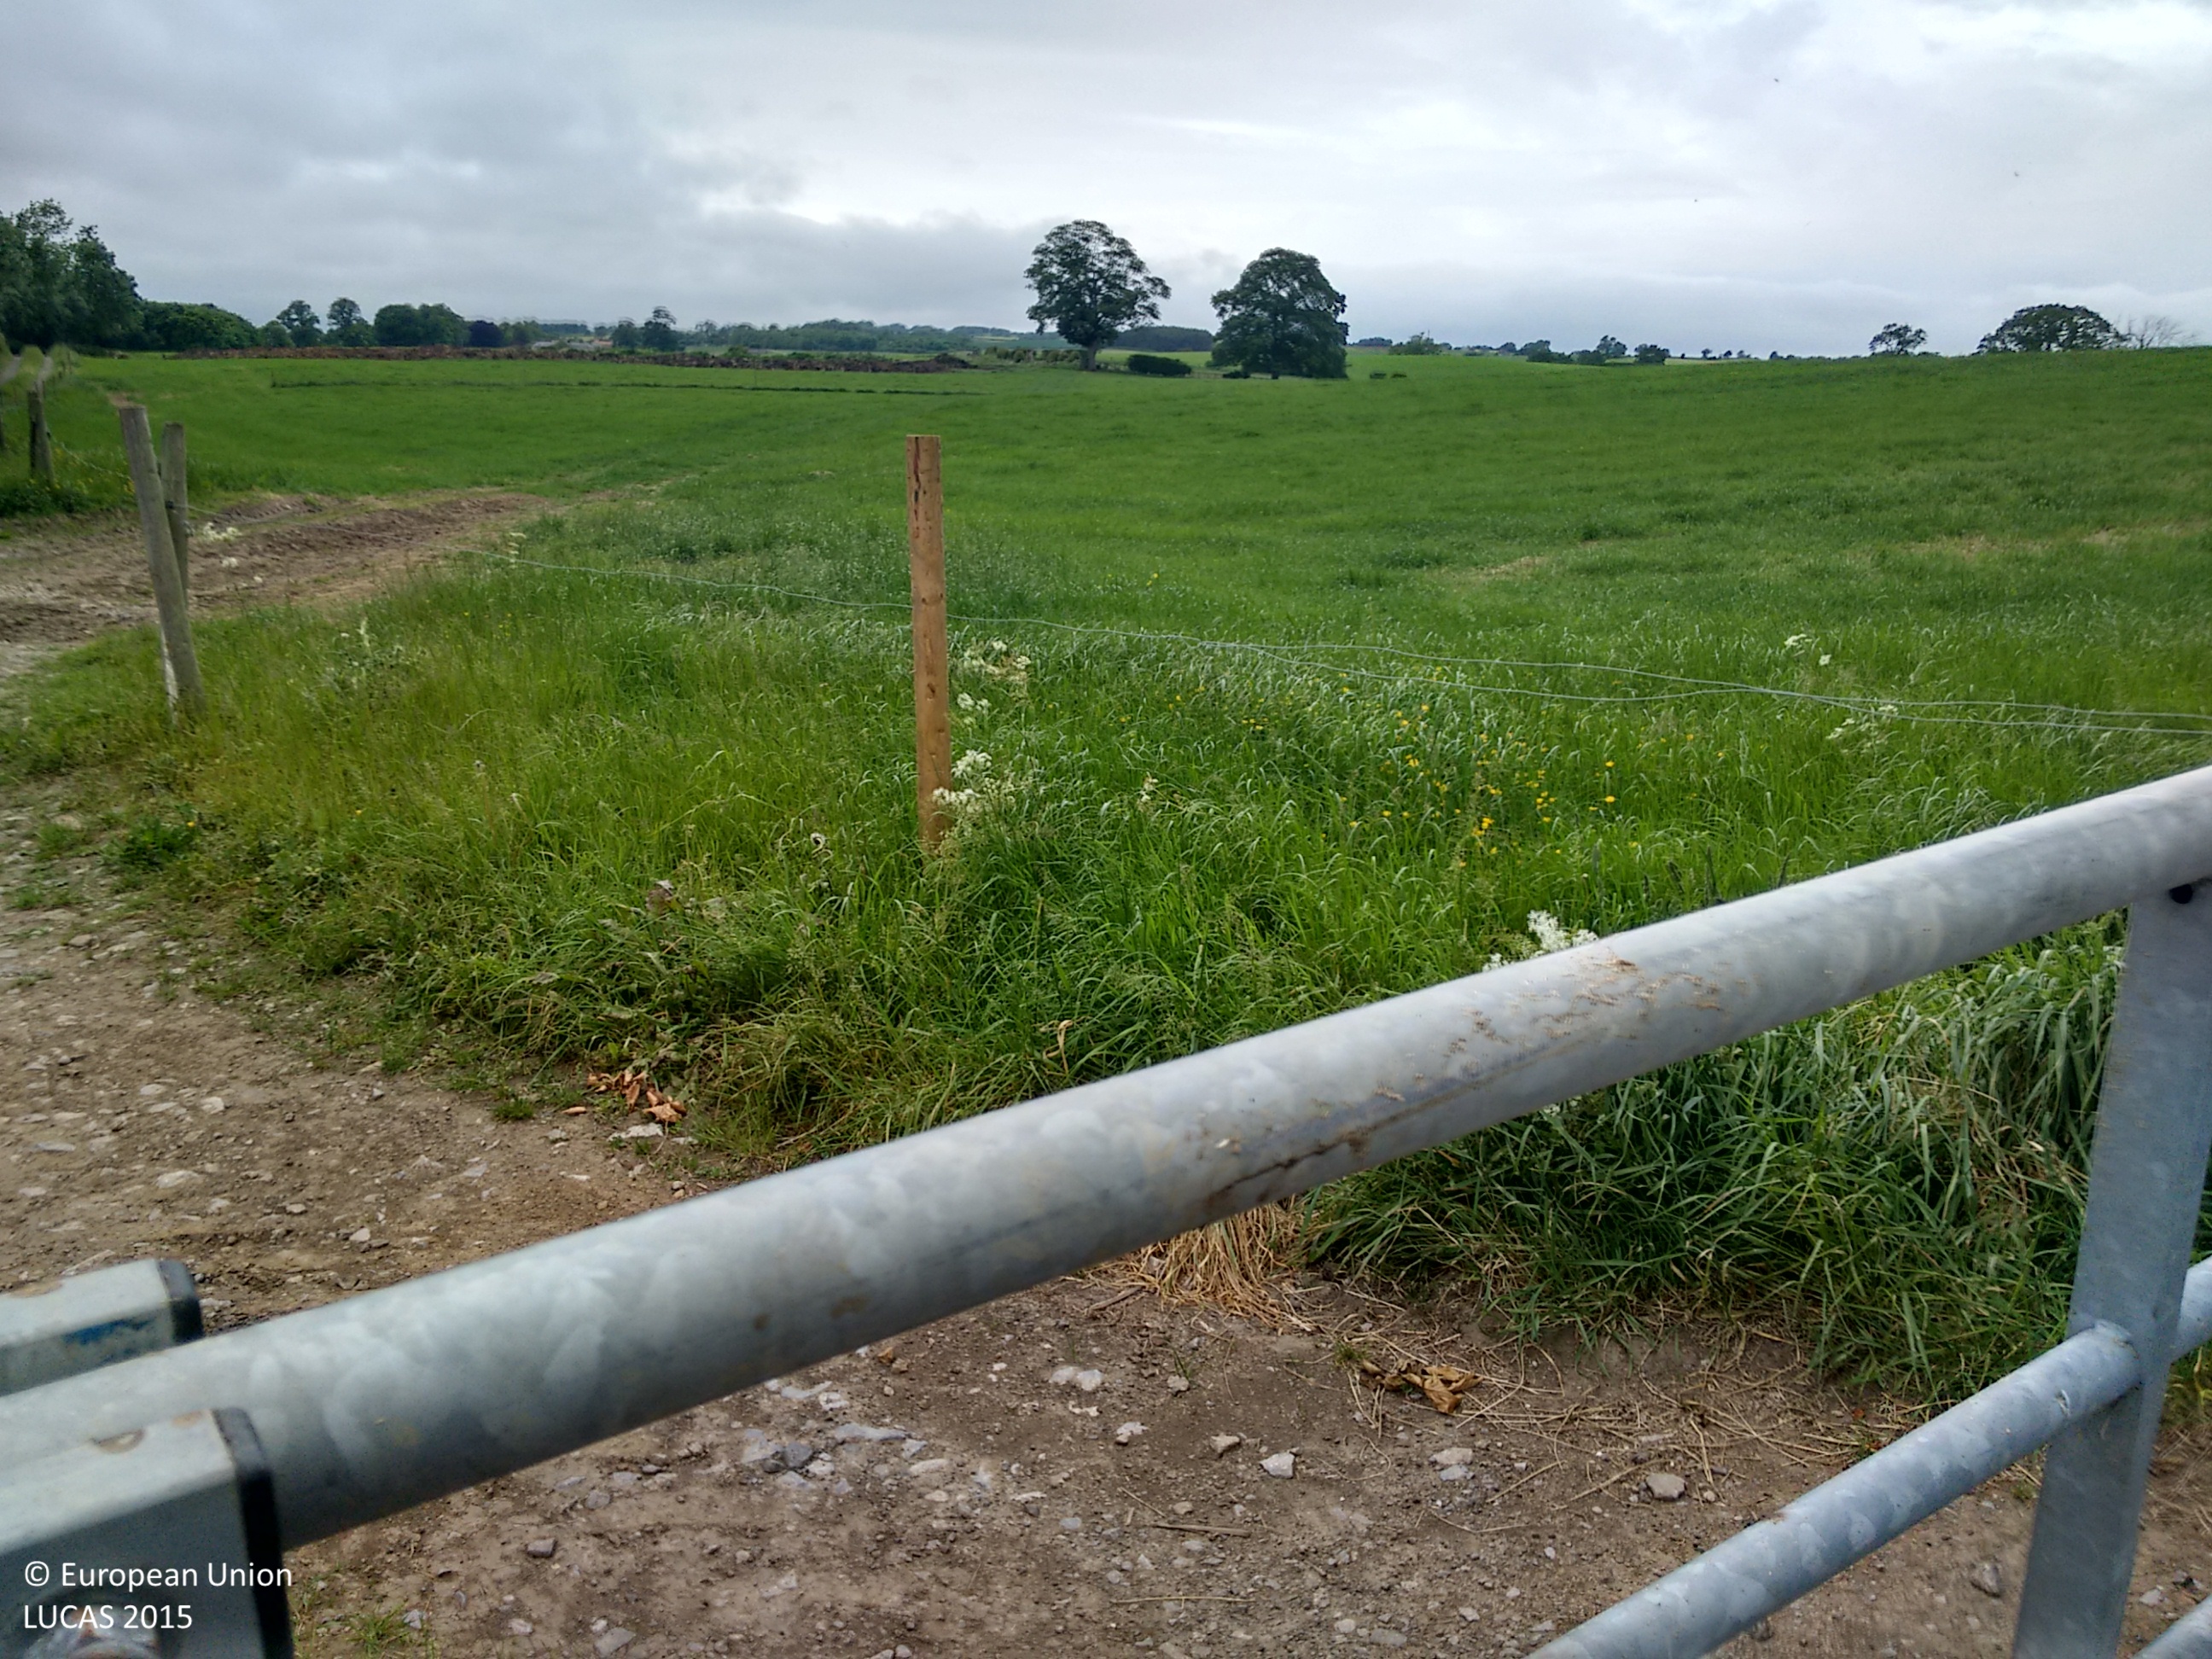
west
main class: Grassland
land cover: Grassland without tree/shrub cover
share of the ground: > 75 %
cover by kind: herbaceous plants 100 %
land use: Agriculture (excluding fallow land and kitchen gardens)
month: June
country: GB
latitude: 54.3474
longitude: -1.6349
